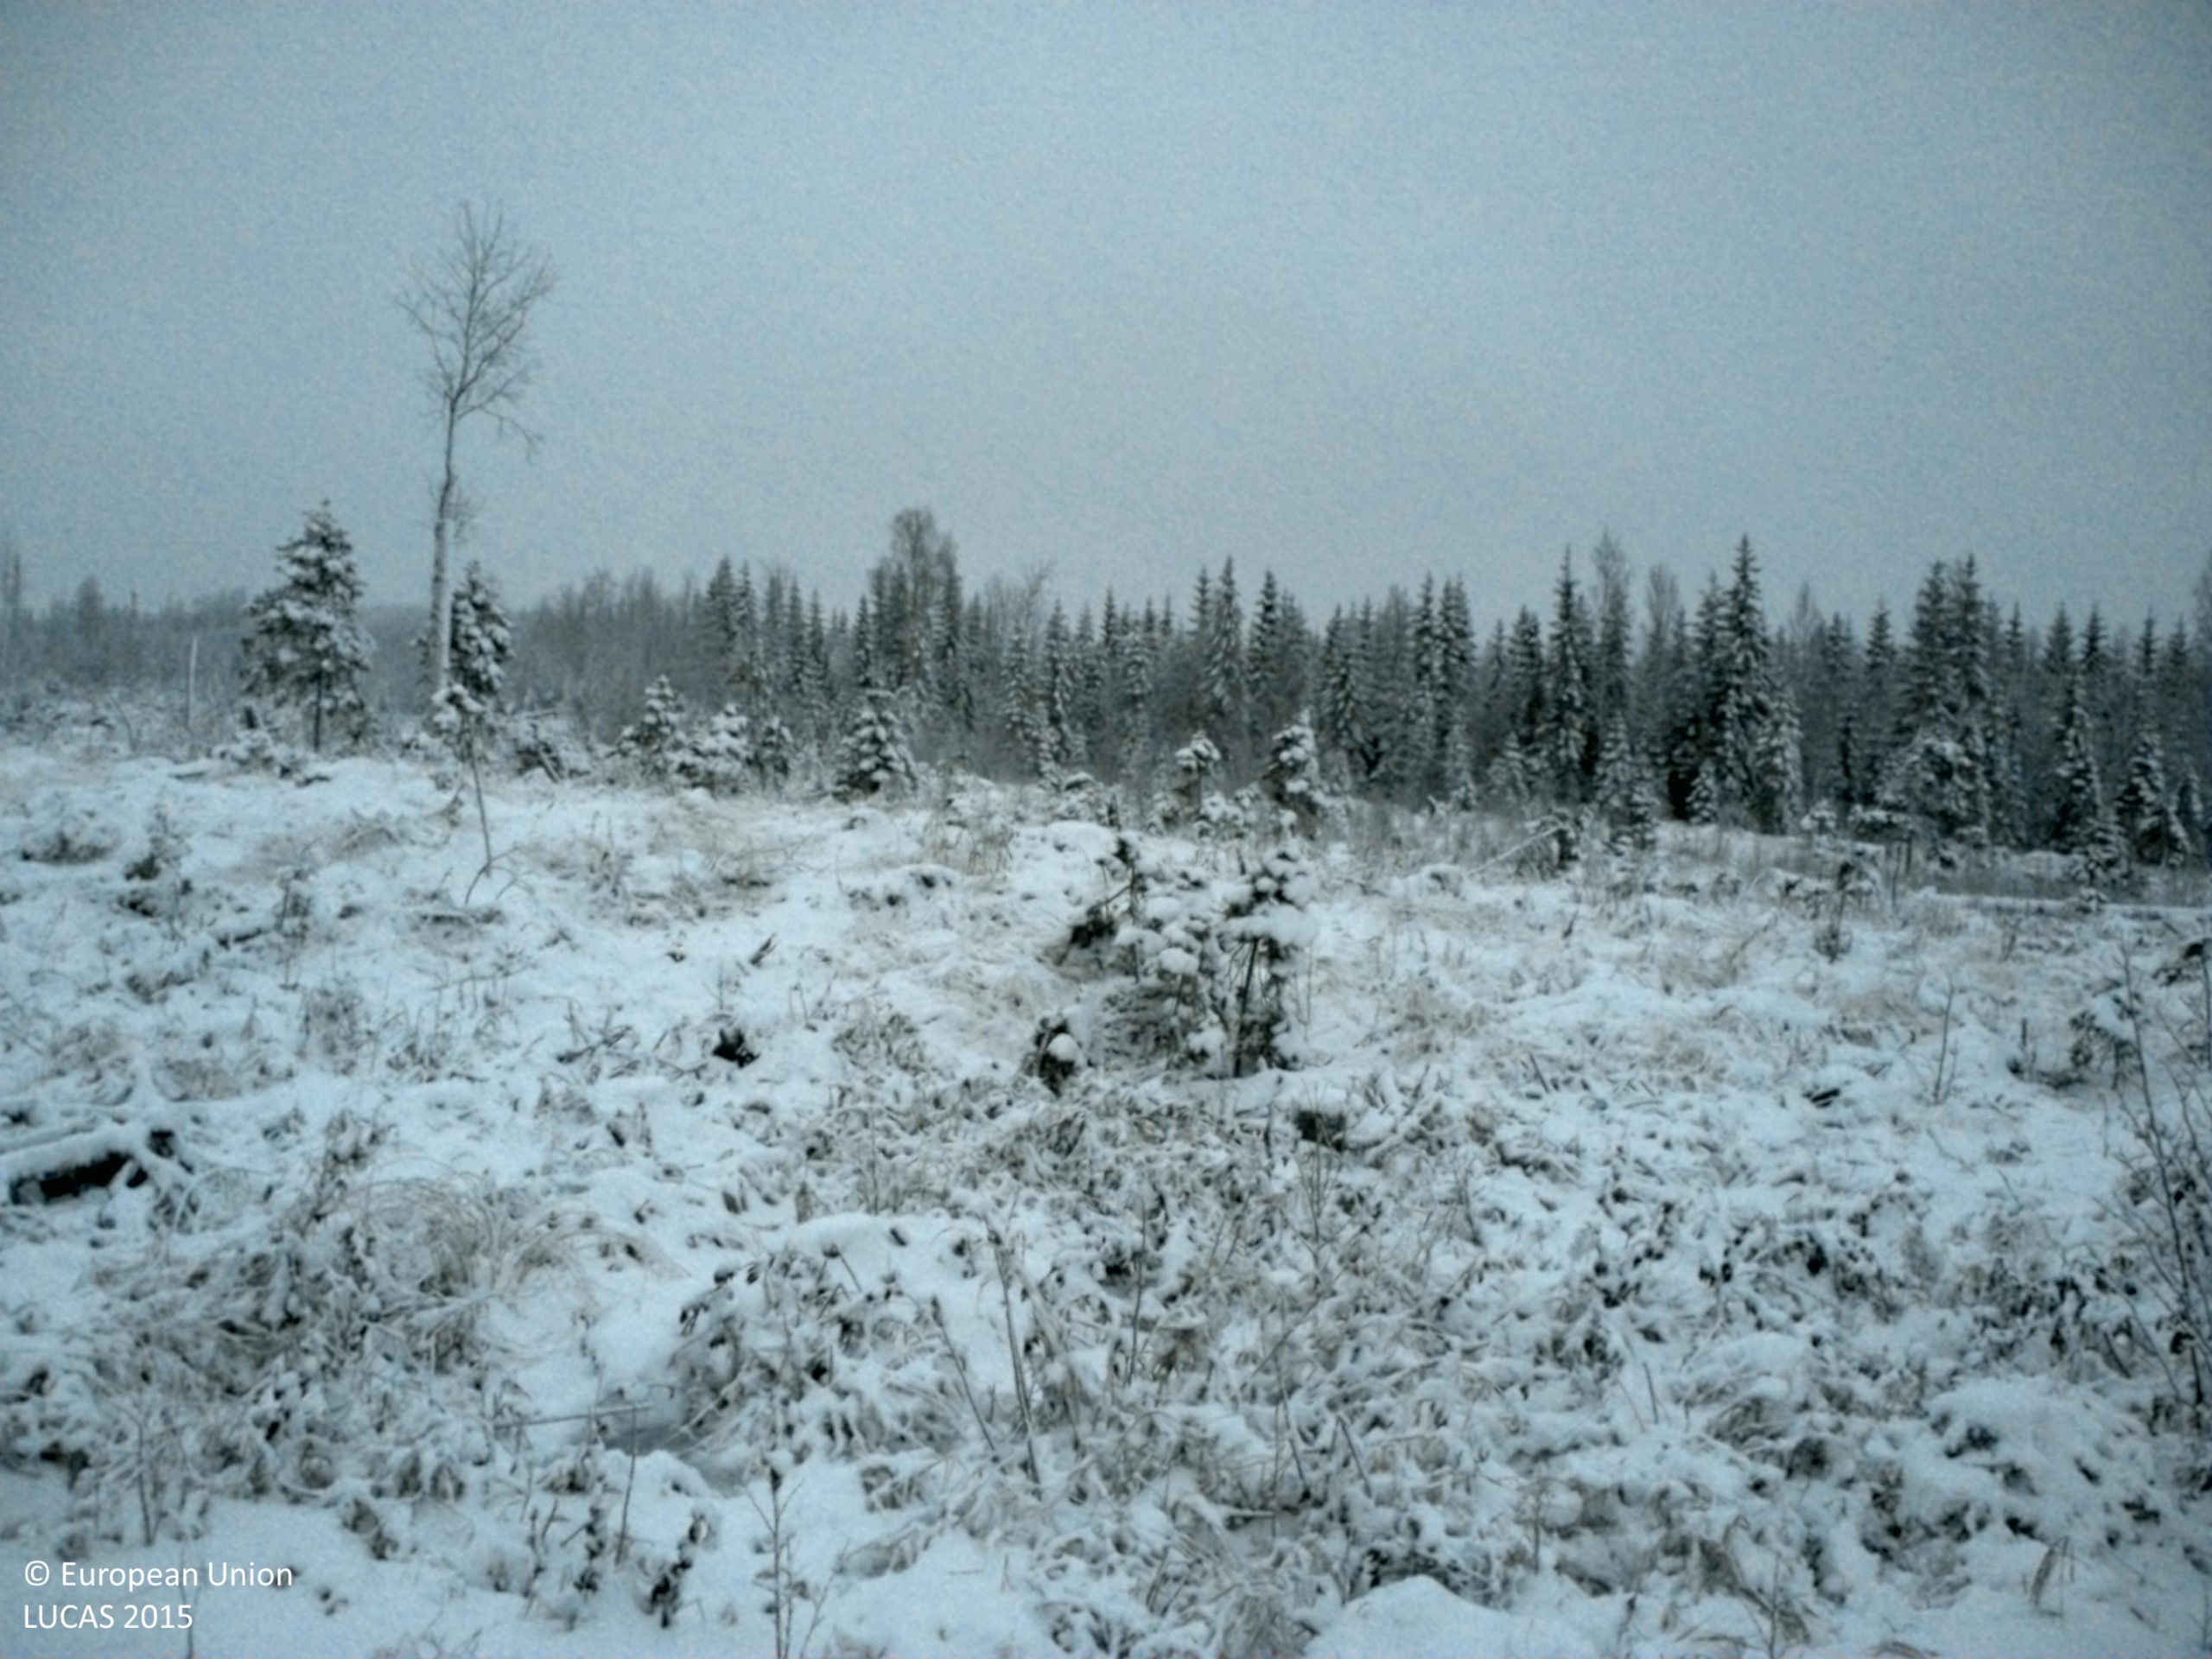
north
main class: Woodland
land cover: Spruce dominated mixed woodland
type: boreal forest
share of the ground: 10 - 25 %
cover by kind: herbaceous plants 55 %, lichens and mosses 20 %, coniferous forest trees 10 %, shrubs 10 %, broadleaved forest trees 5 %
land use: Forestry
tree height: < 5 m
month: November
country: SE
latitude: 63.6700
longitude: 15.9752
